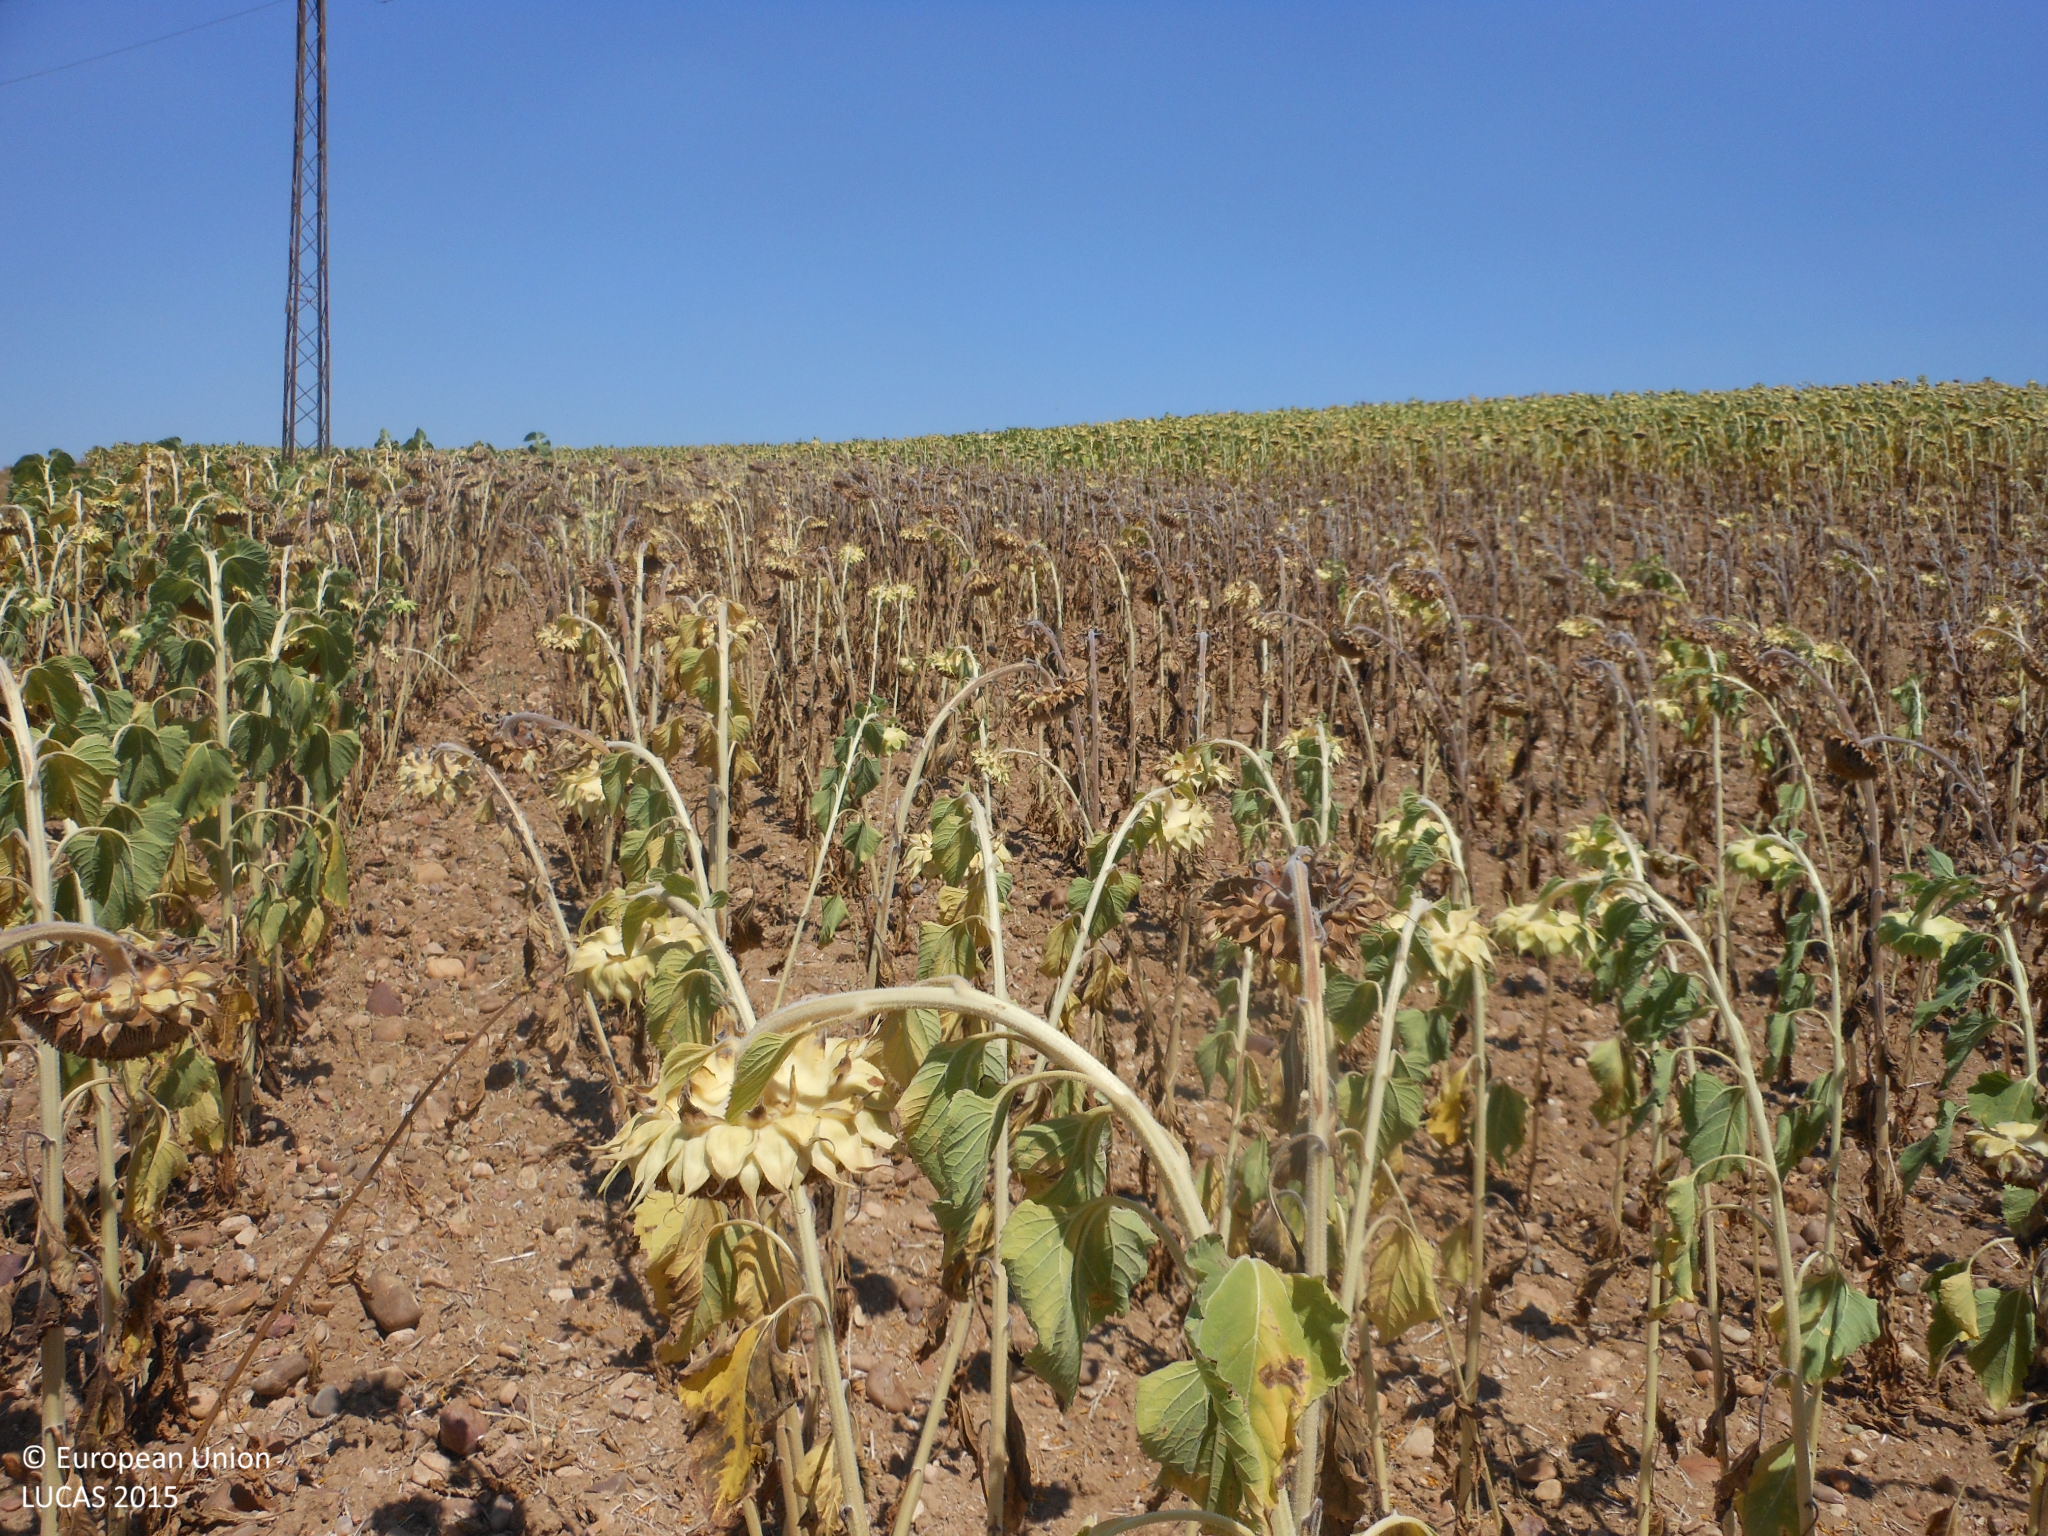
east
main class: Cropland
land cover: Sunflower
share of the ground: > 75 %
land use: Agriculture (excluding fallow land and kitchen gardens)
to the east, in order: Sunflower
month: June
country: ES
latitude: 37.5489
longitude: -5.5377
